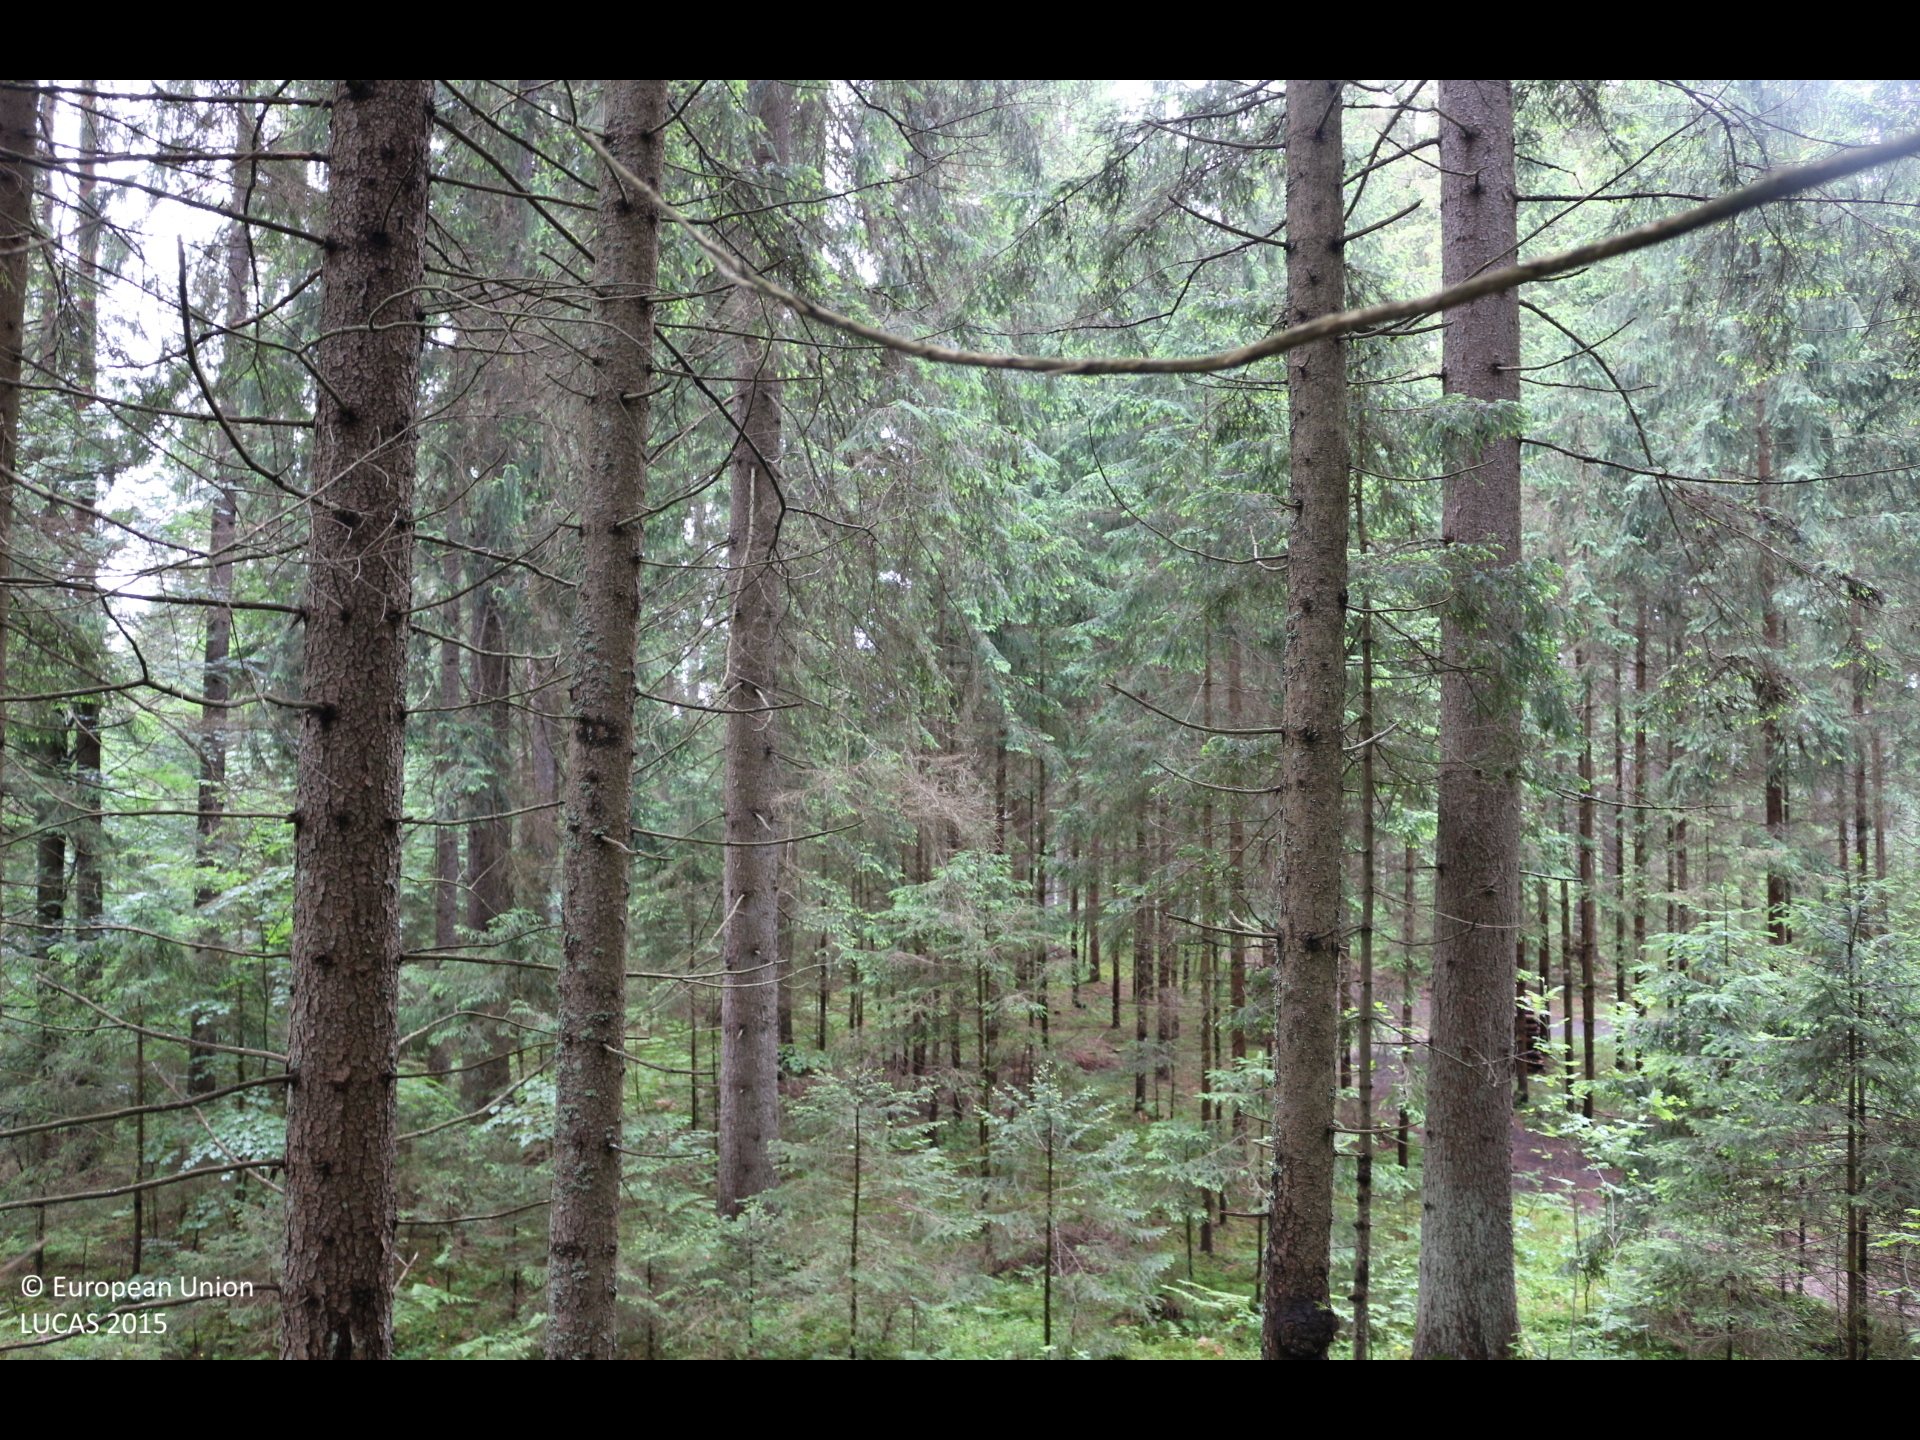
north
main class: Woodland
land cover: Spruce dominated coniferous woodland
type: alpine coniferous forest
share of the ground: > 75 %
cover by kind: coniferous forest trees 95 %, broadleaved forest trees 5 %
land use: Forestry
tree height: > 5 m
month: May
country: AT
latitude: 46.6868
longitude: 14.1161
